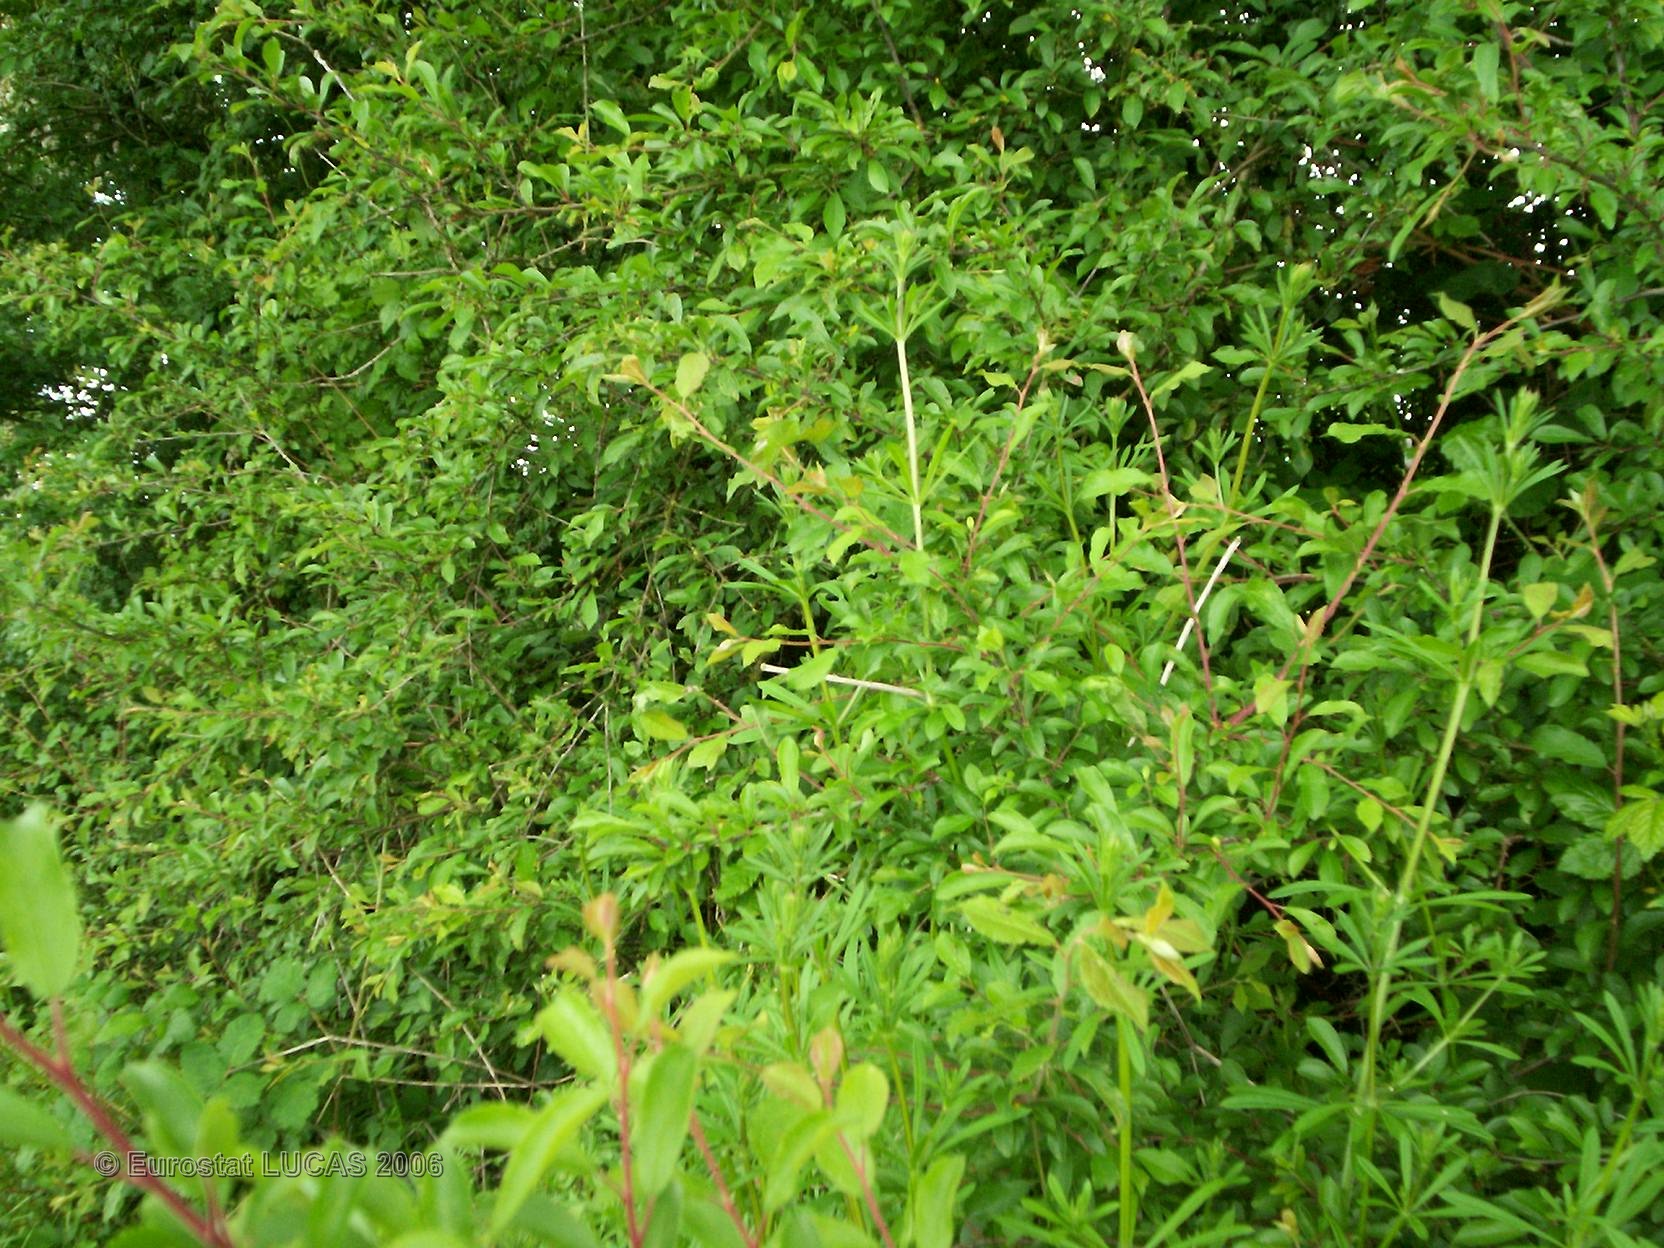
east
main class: Cropland
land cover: Other leguminous and mixtures for fodder
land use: Agriculture (excluding fallow land and kitchen gardens)
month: May
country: FR
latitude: 47.2111
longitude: -1.0606
